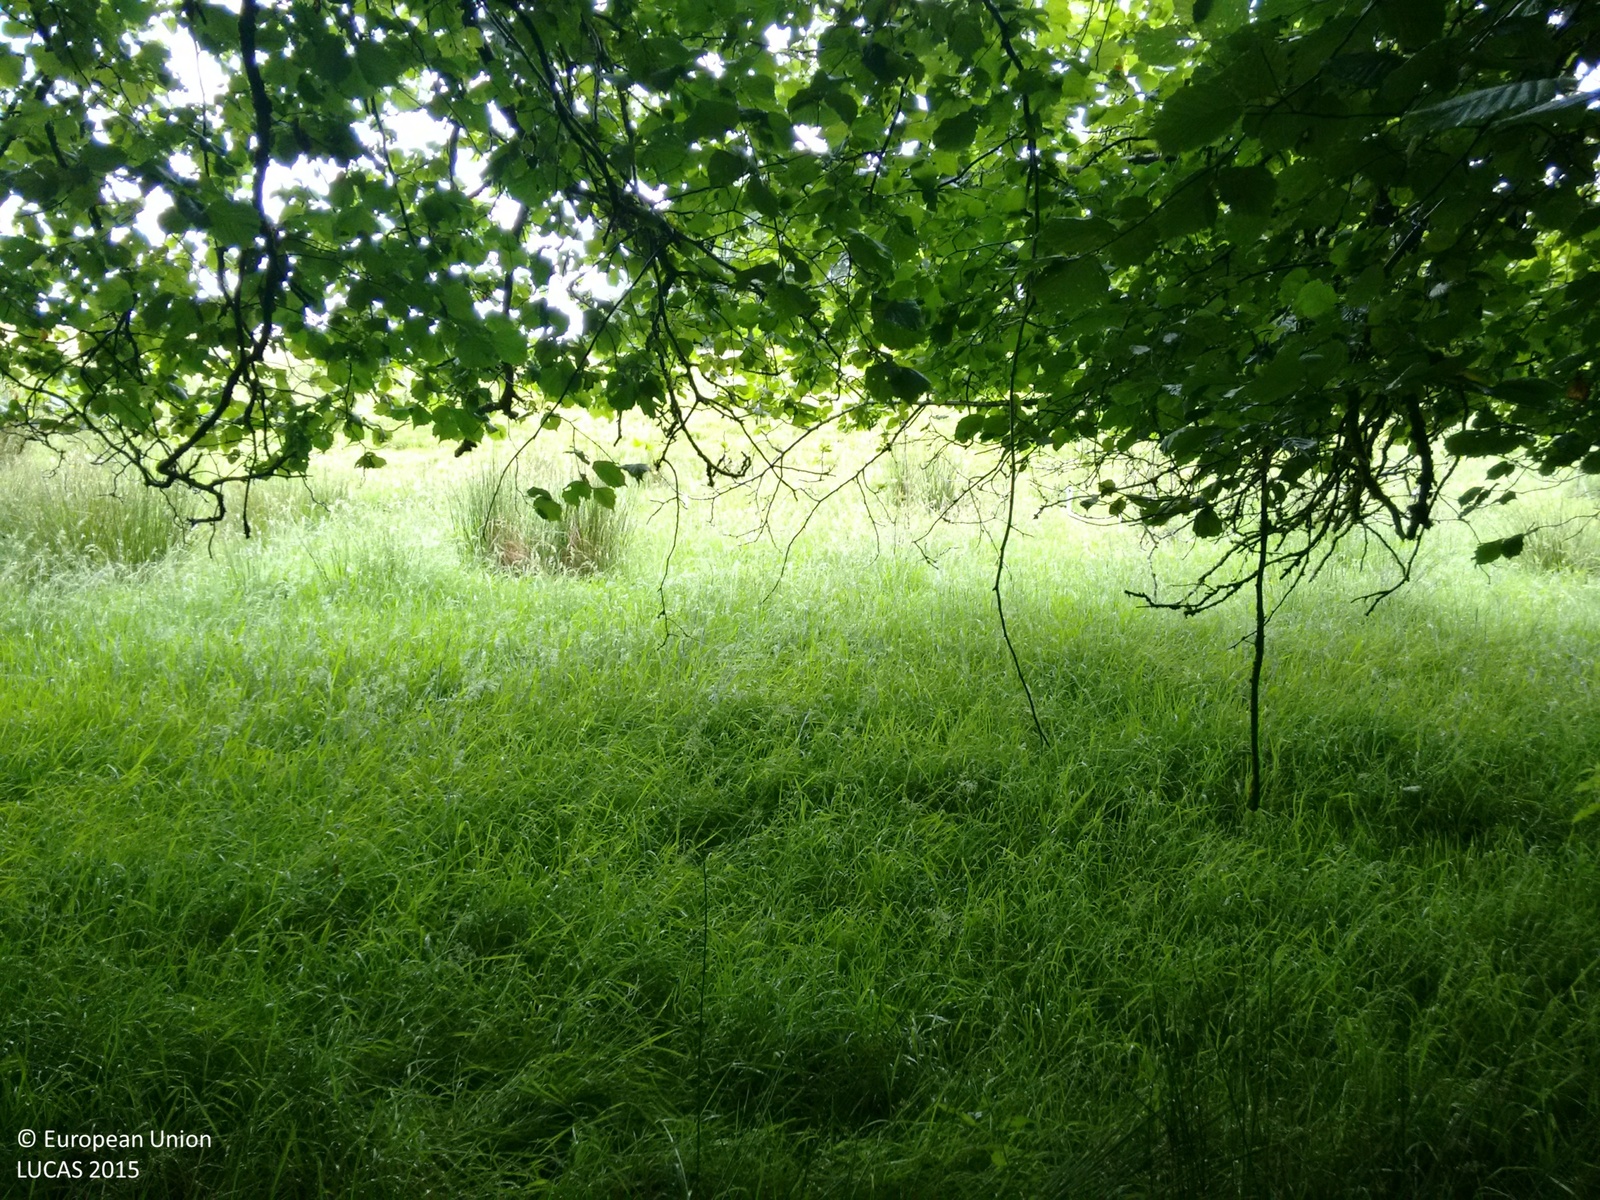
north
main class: Woodland
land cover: Broadleaved woodland
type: mesophytic deciduous forest
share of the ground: > 75 %
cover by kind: broadleaved forest trees 100 %
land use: Semi-natural and natural areas not in use
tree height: > 5 m
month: July
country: GB
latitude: 51.0115
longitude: -3.5546
